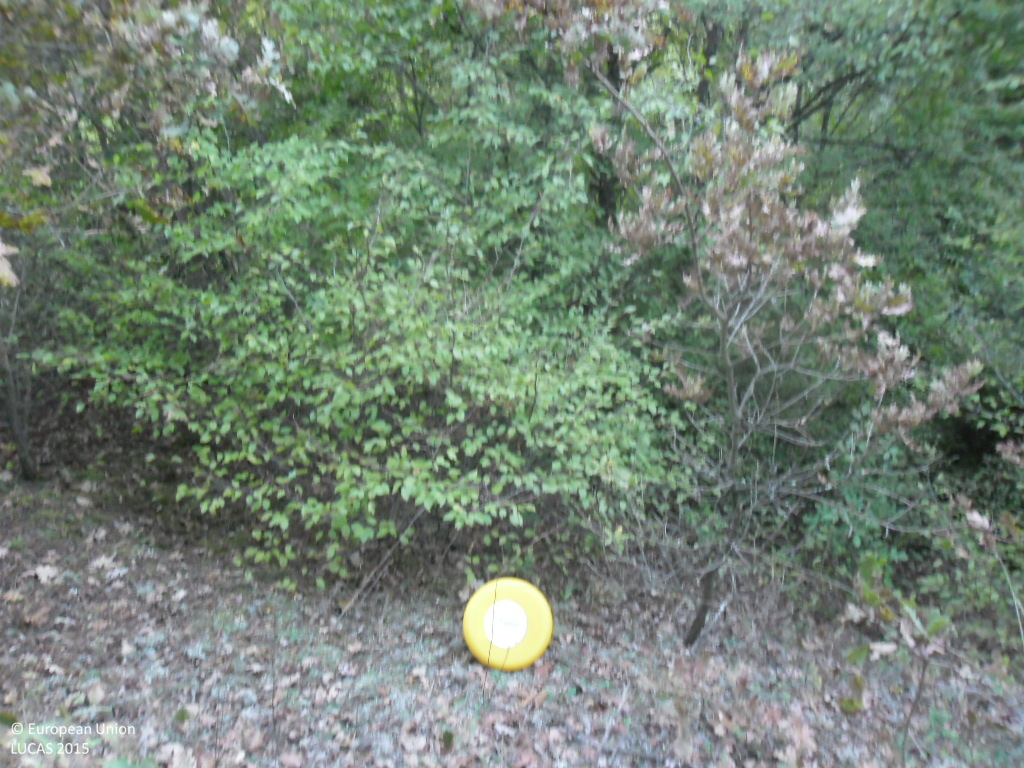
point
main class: Woodland
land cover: Broadleaved woodland
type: mesophytic deciduous forest
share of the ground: > 75 %
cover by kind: broadleaved forest trees 75 %, herbaceous plants 15 %, shrubs 5 %, unconsolidated bare surface 5 %
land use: Forestry
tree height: < 5 m
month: October
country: BG
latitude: 42.0692
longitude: 22.9916
